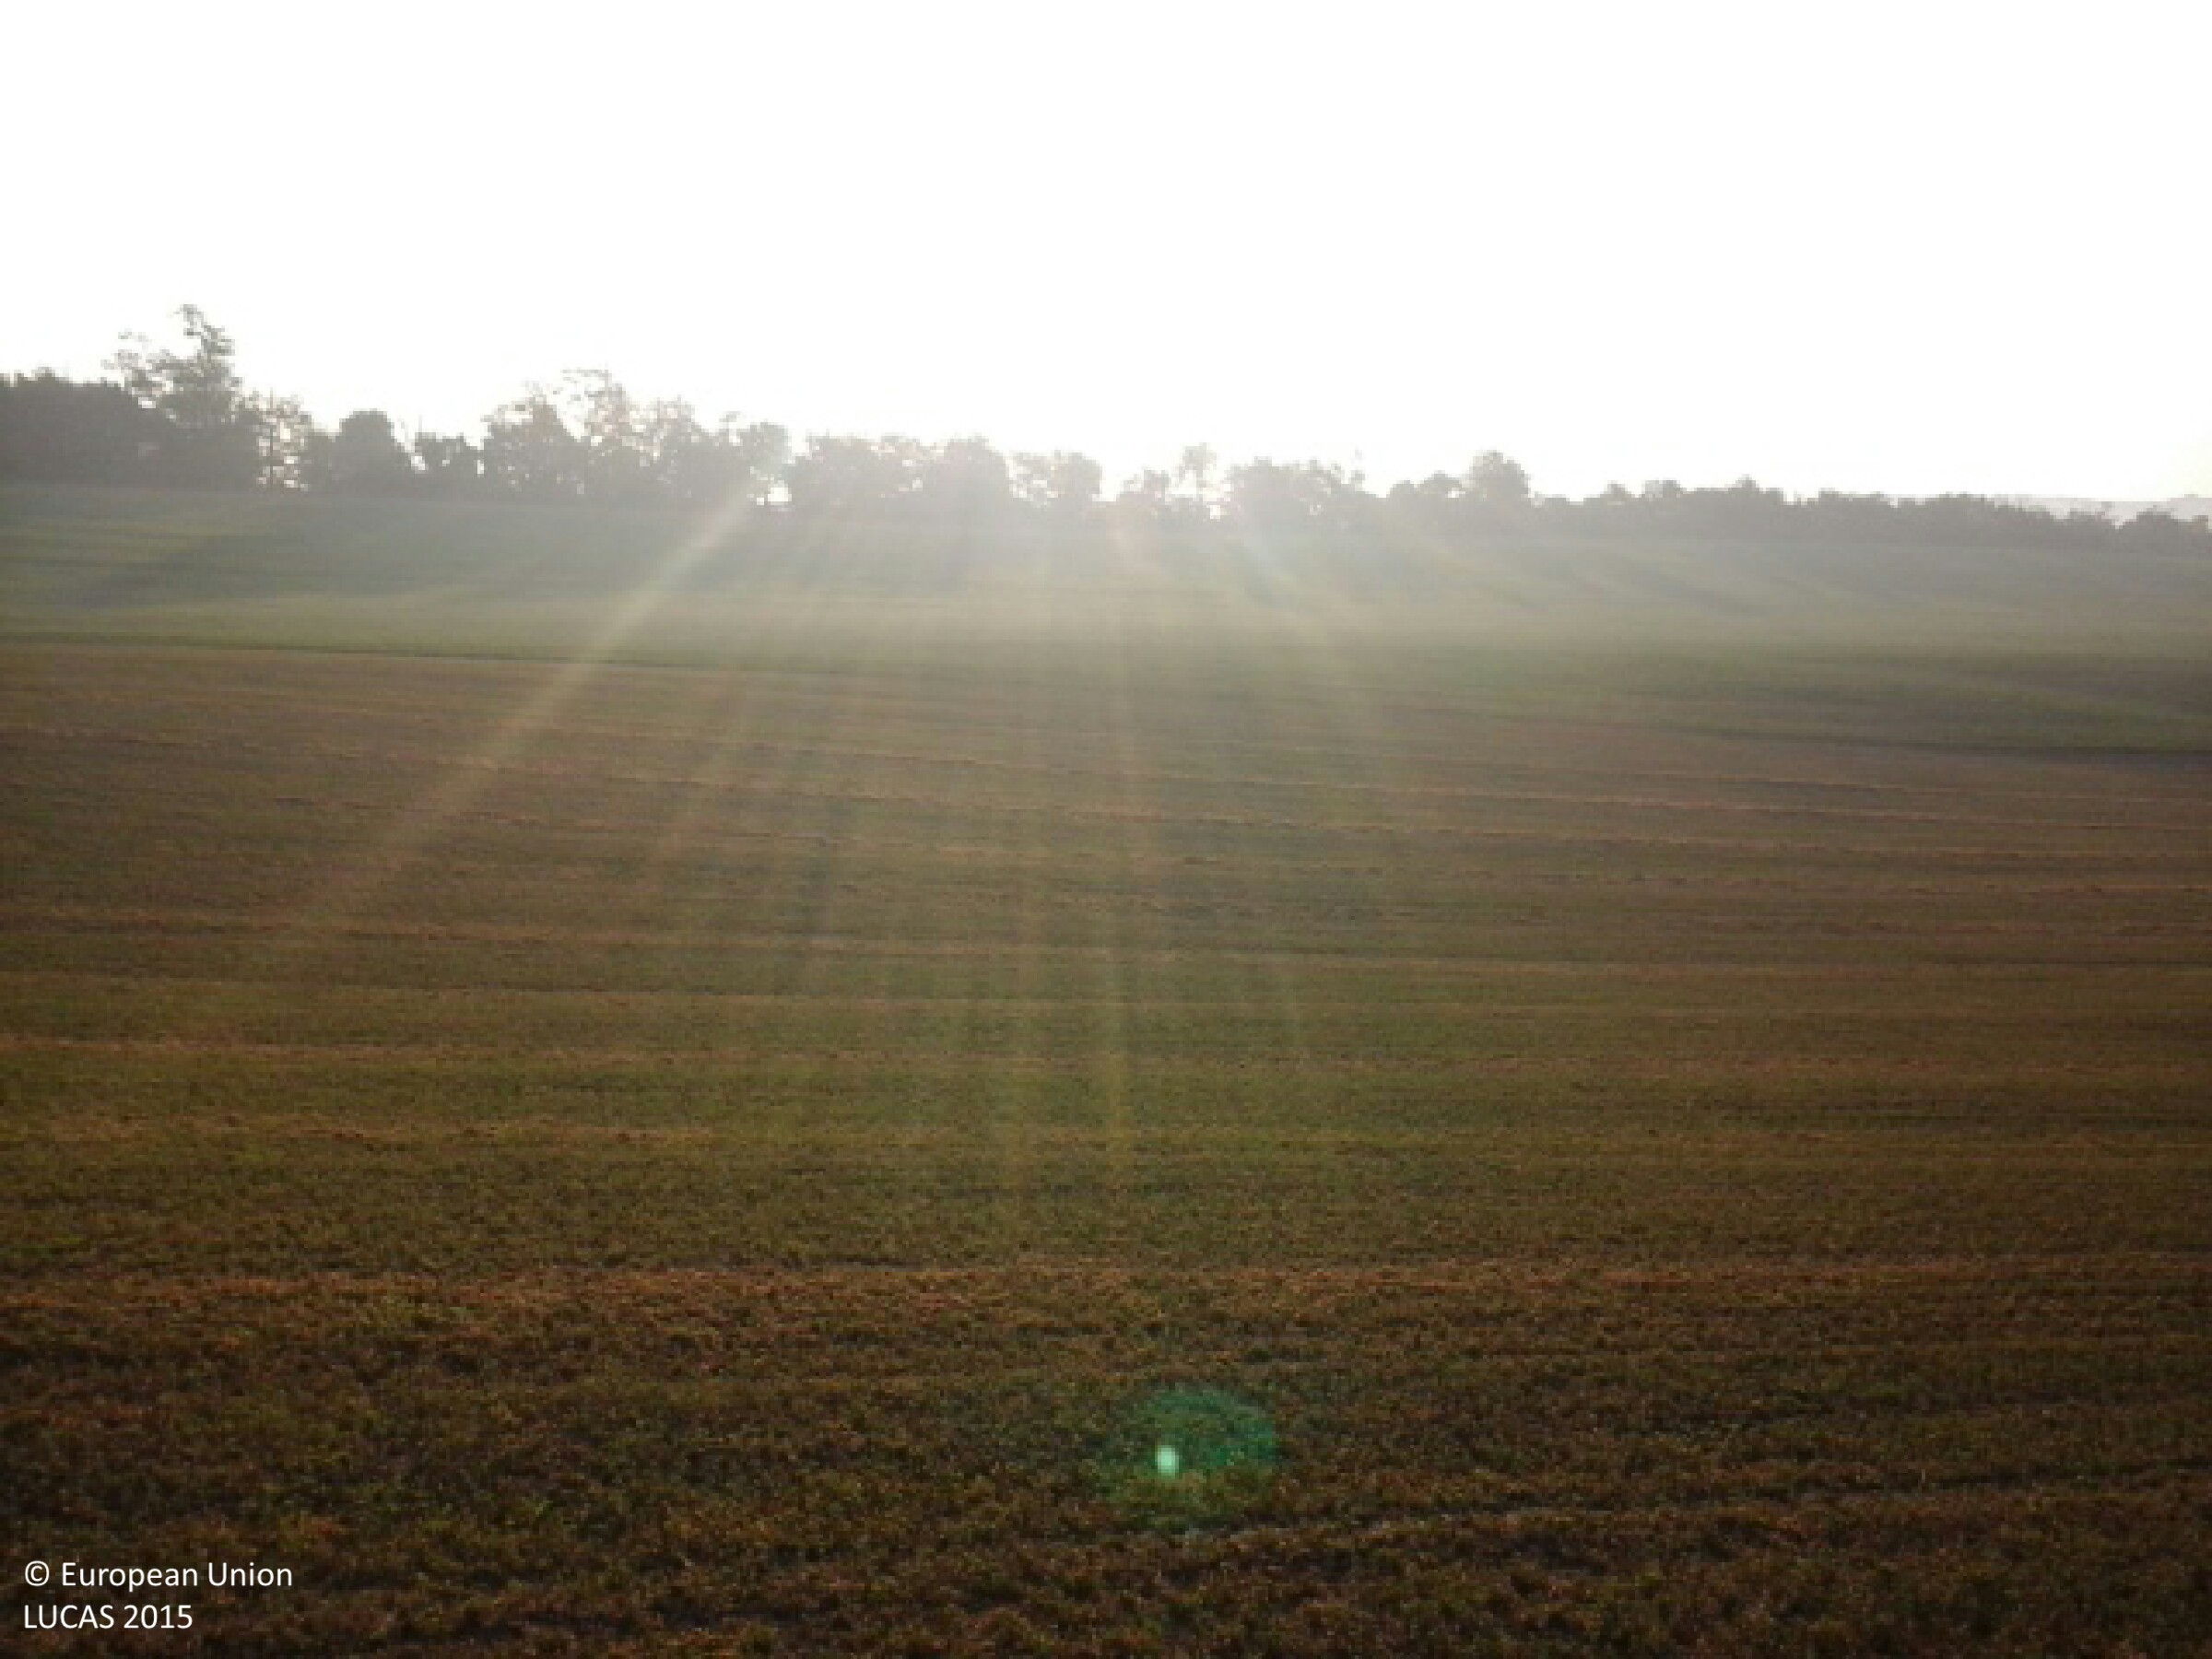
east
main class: Cropland
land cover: Lucerne
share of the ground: 50 - 75 %
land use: Agriculture (excluding fallow land and kitchen gardens)
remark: Harvested field
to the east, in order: Lucerne
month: August
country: HU
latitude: 47.5465
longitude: 18.5579
